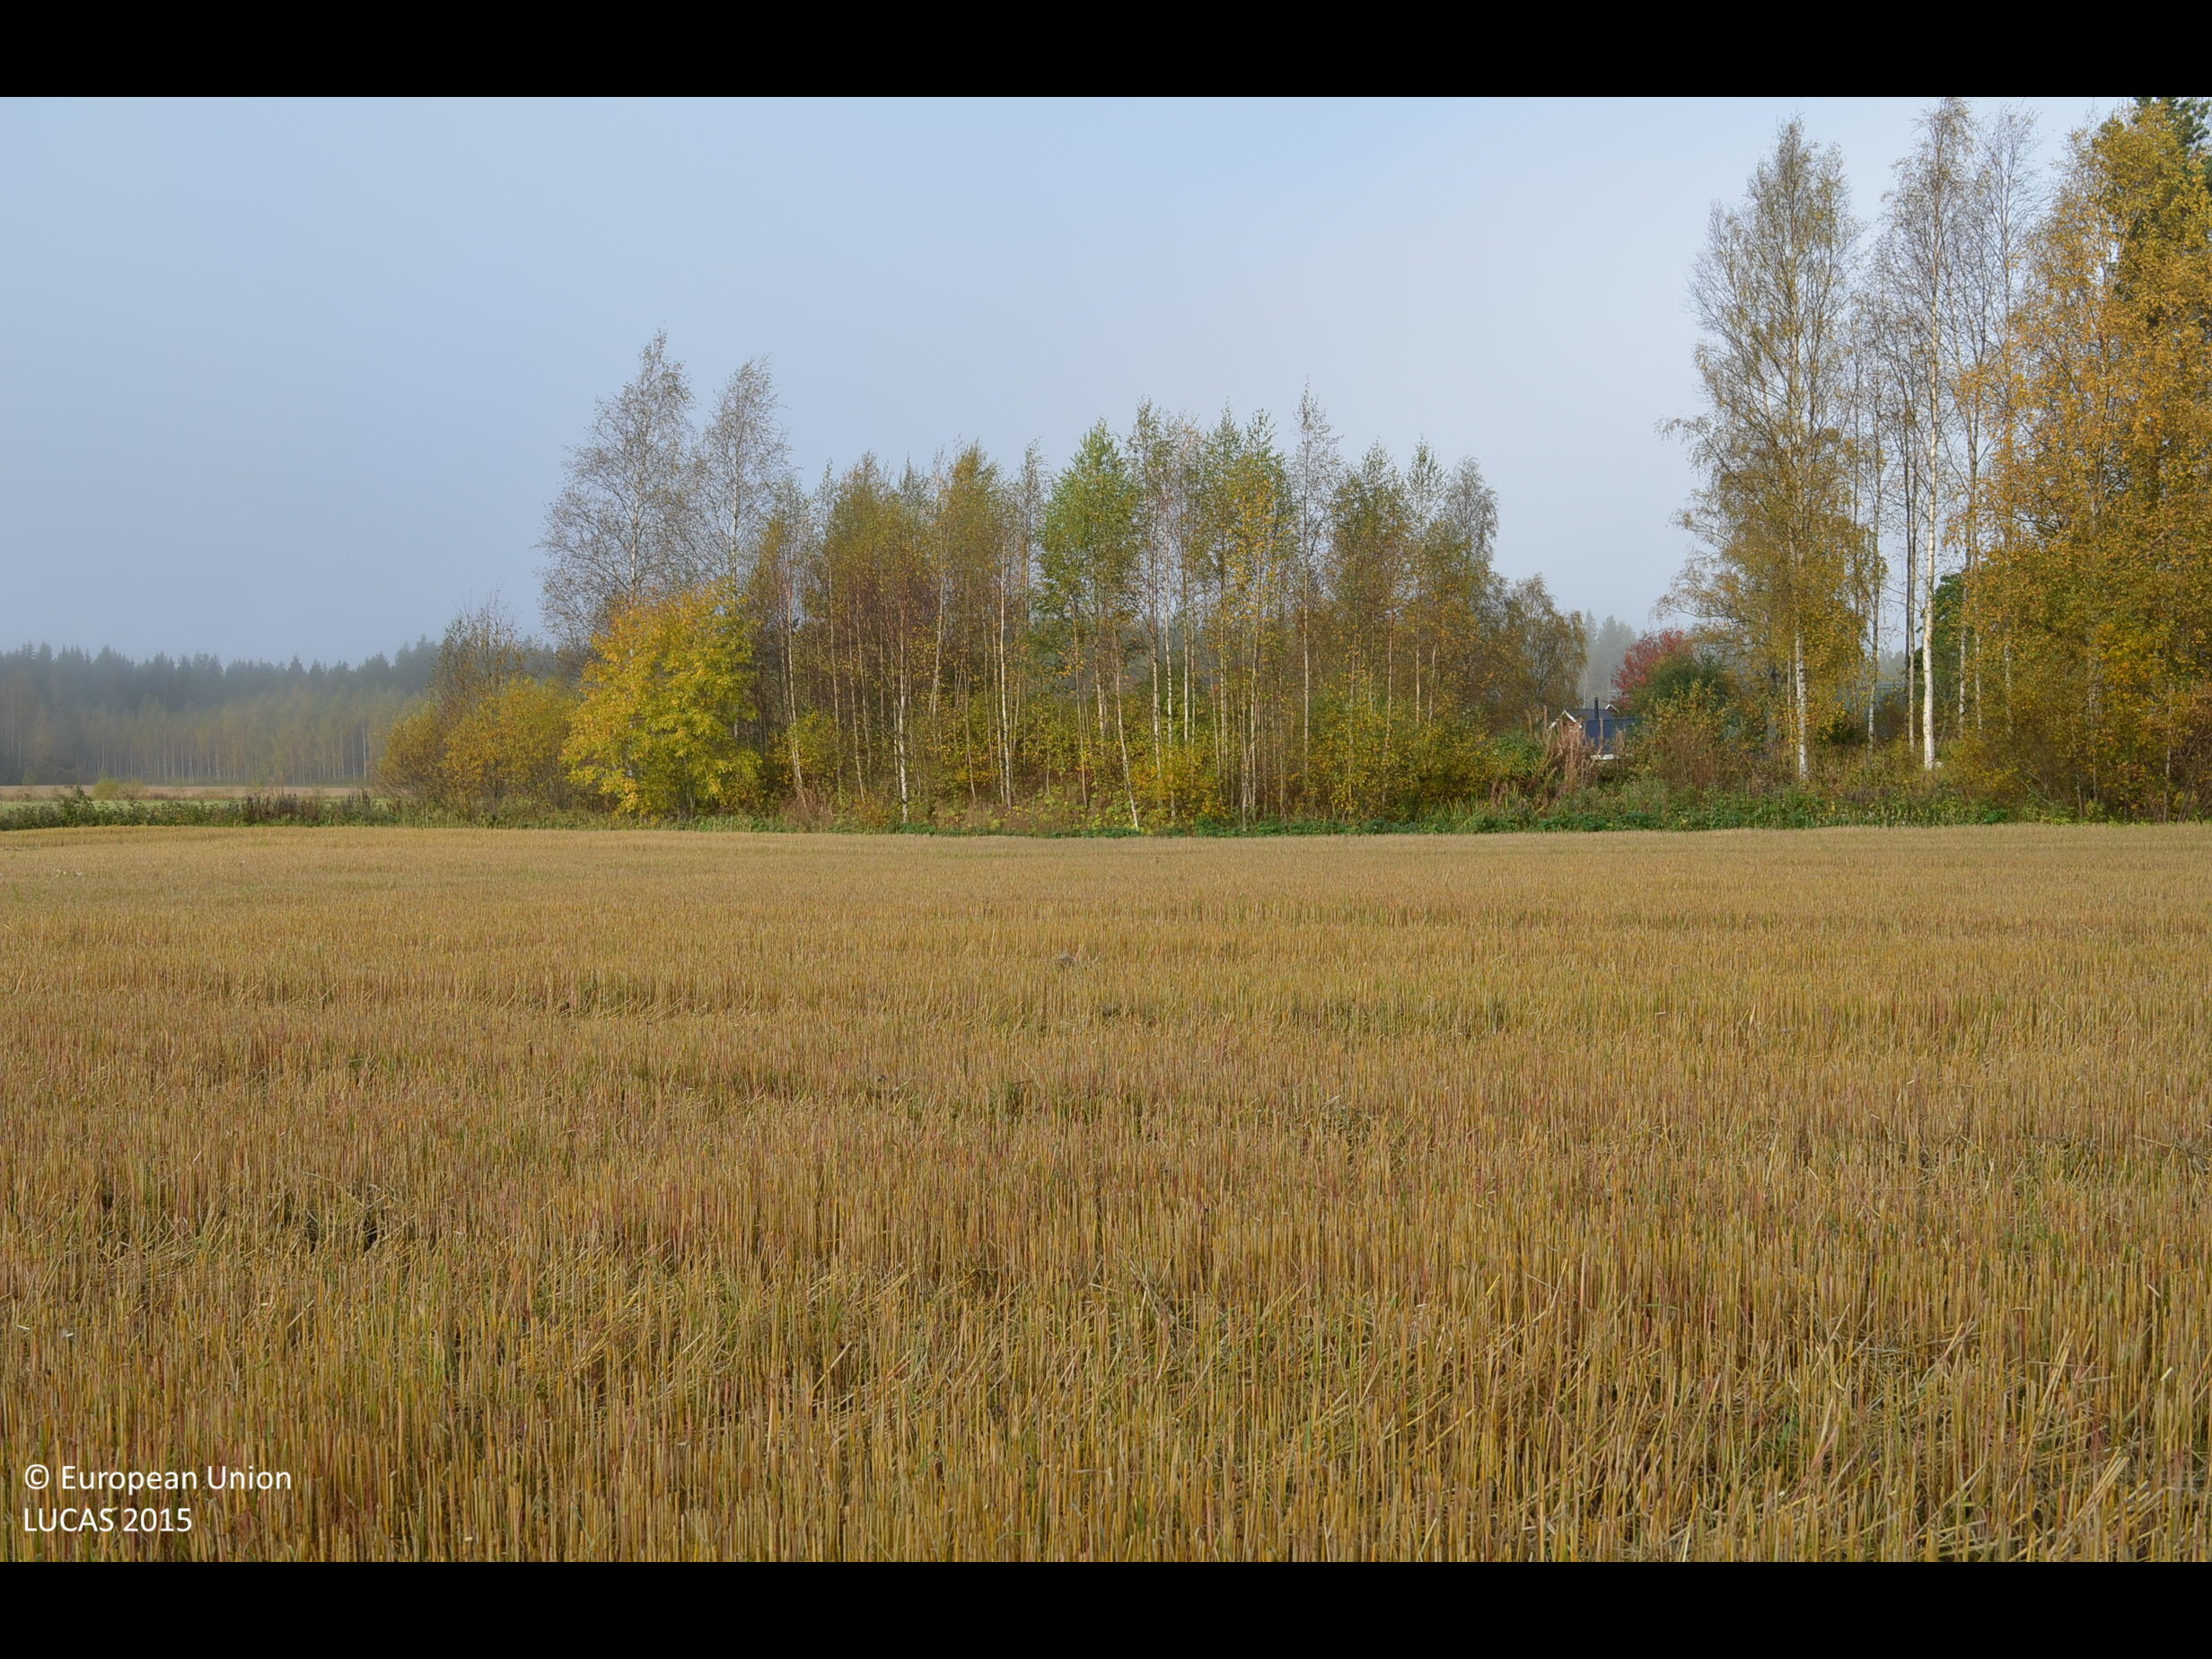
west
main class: Cropland
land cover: Oats
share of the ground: > 75 %
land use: Agriculture (excluding fallow land and kitchen gardens)
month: September
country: FI
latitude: 62.5998
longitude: 23.5694
